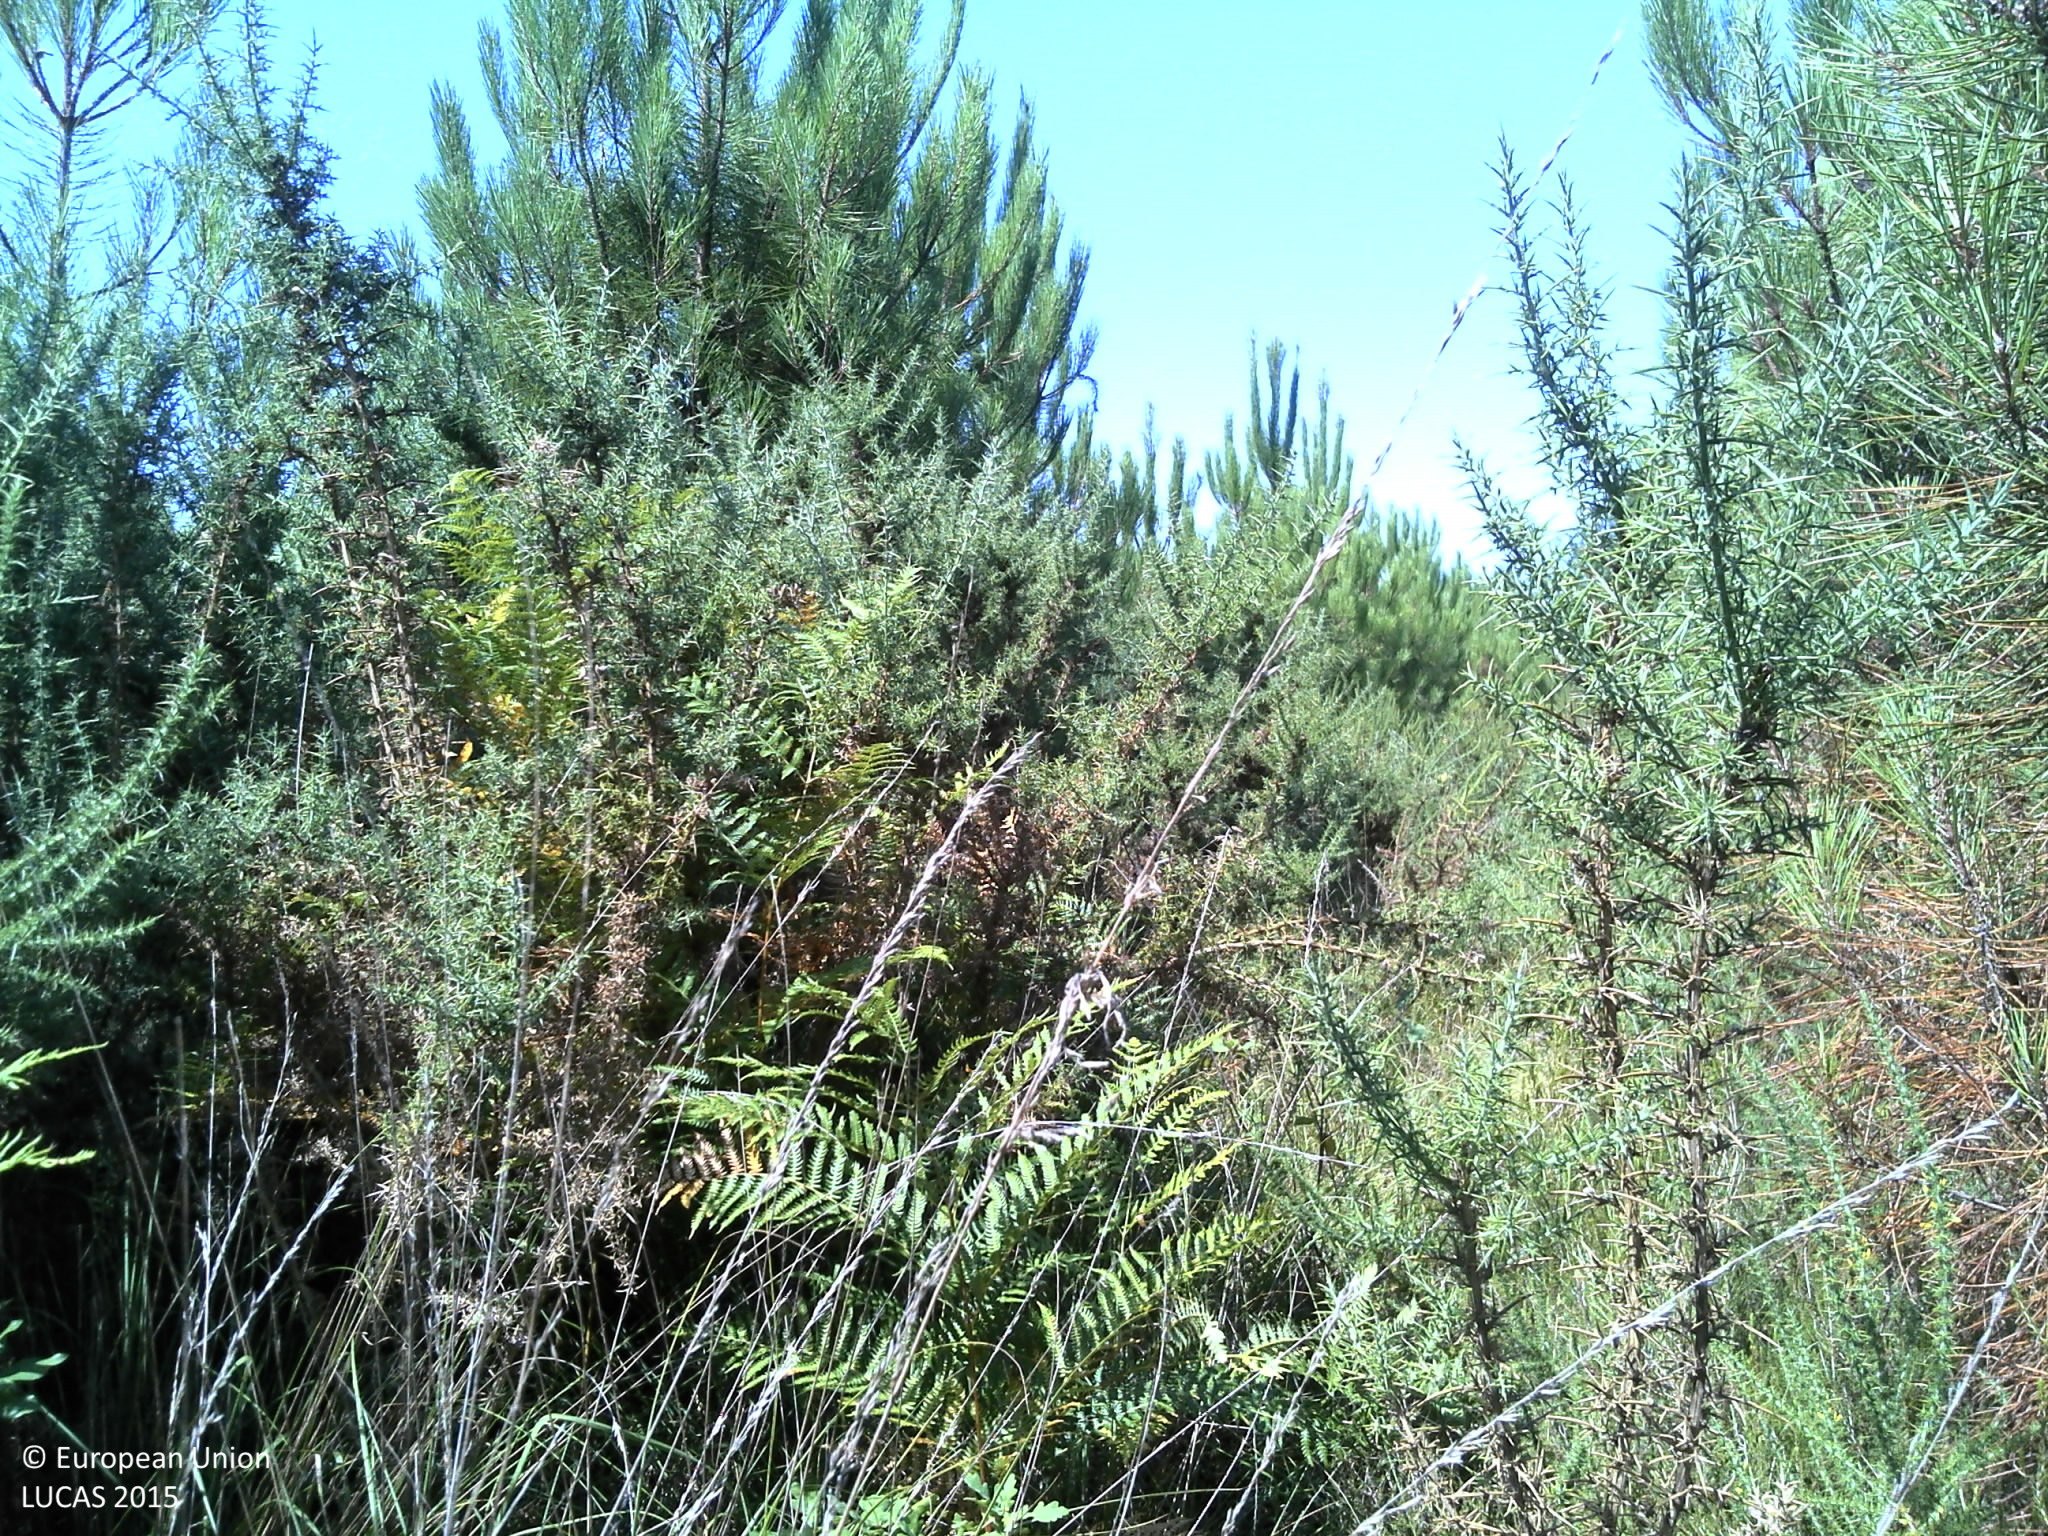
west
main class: Woodland
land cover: Pine dominated coniferous woodland
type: coniferous forest of the mediterranean region
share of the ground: > 75 %
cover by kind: coniferous forest trees 60 %, shrubs 30 %, herbaceous plants 5 %, lichens and mosses 5 %
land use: Forestry
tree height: > 5 m
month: August
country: FR
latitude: 45.0311
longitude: -1.0544
